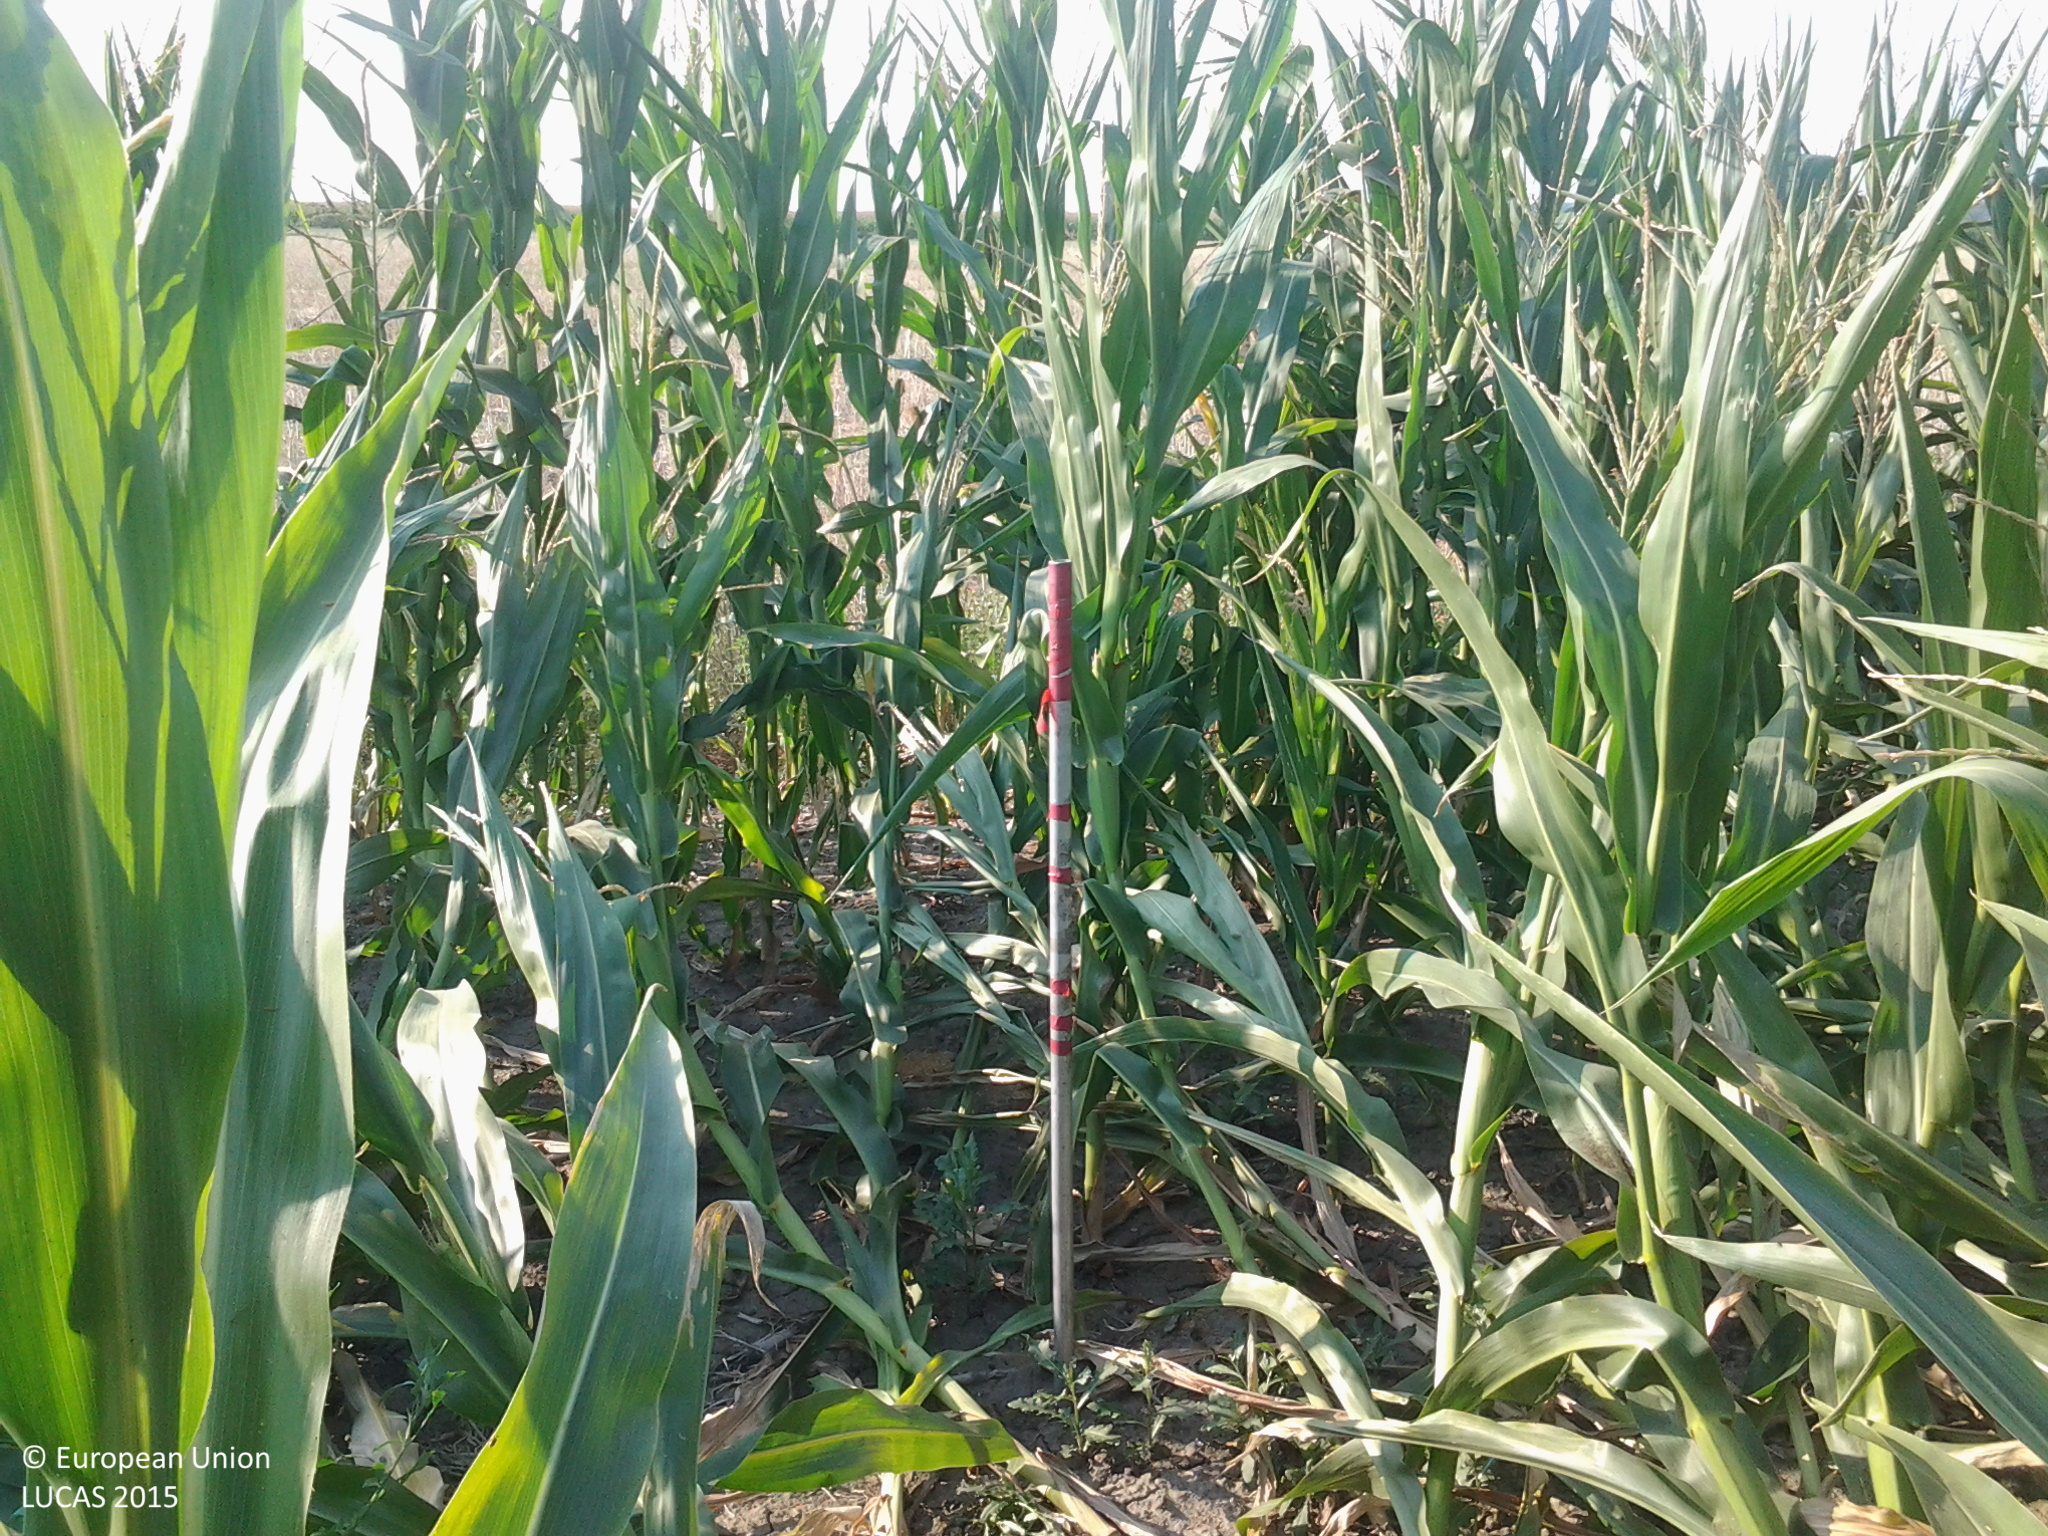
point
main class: Cropland
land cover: Maize
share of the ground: > 75 %
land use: Agriculture (excluding fallow land and kitchen gardens)
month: July
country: HU
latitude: 46.7874
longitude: 18.9877
